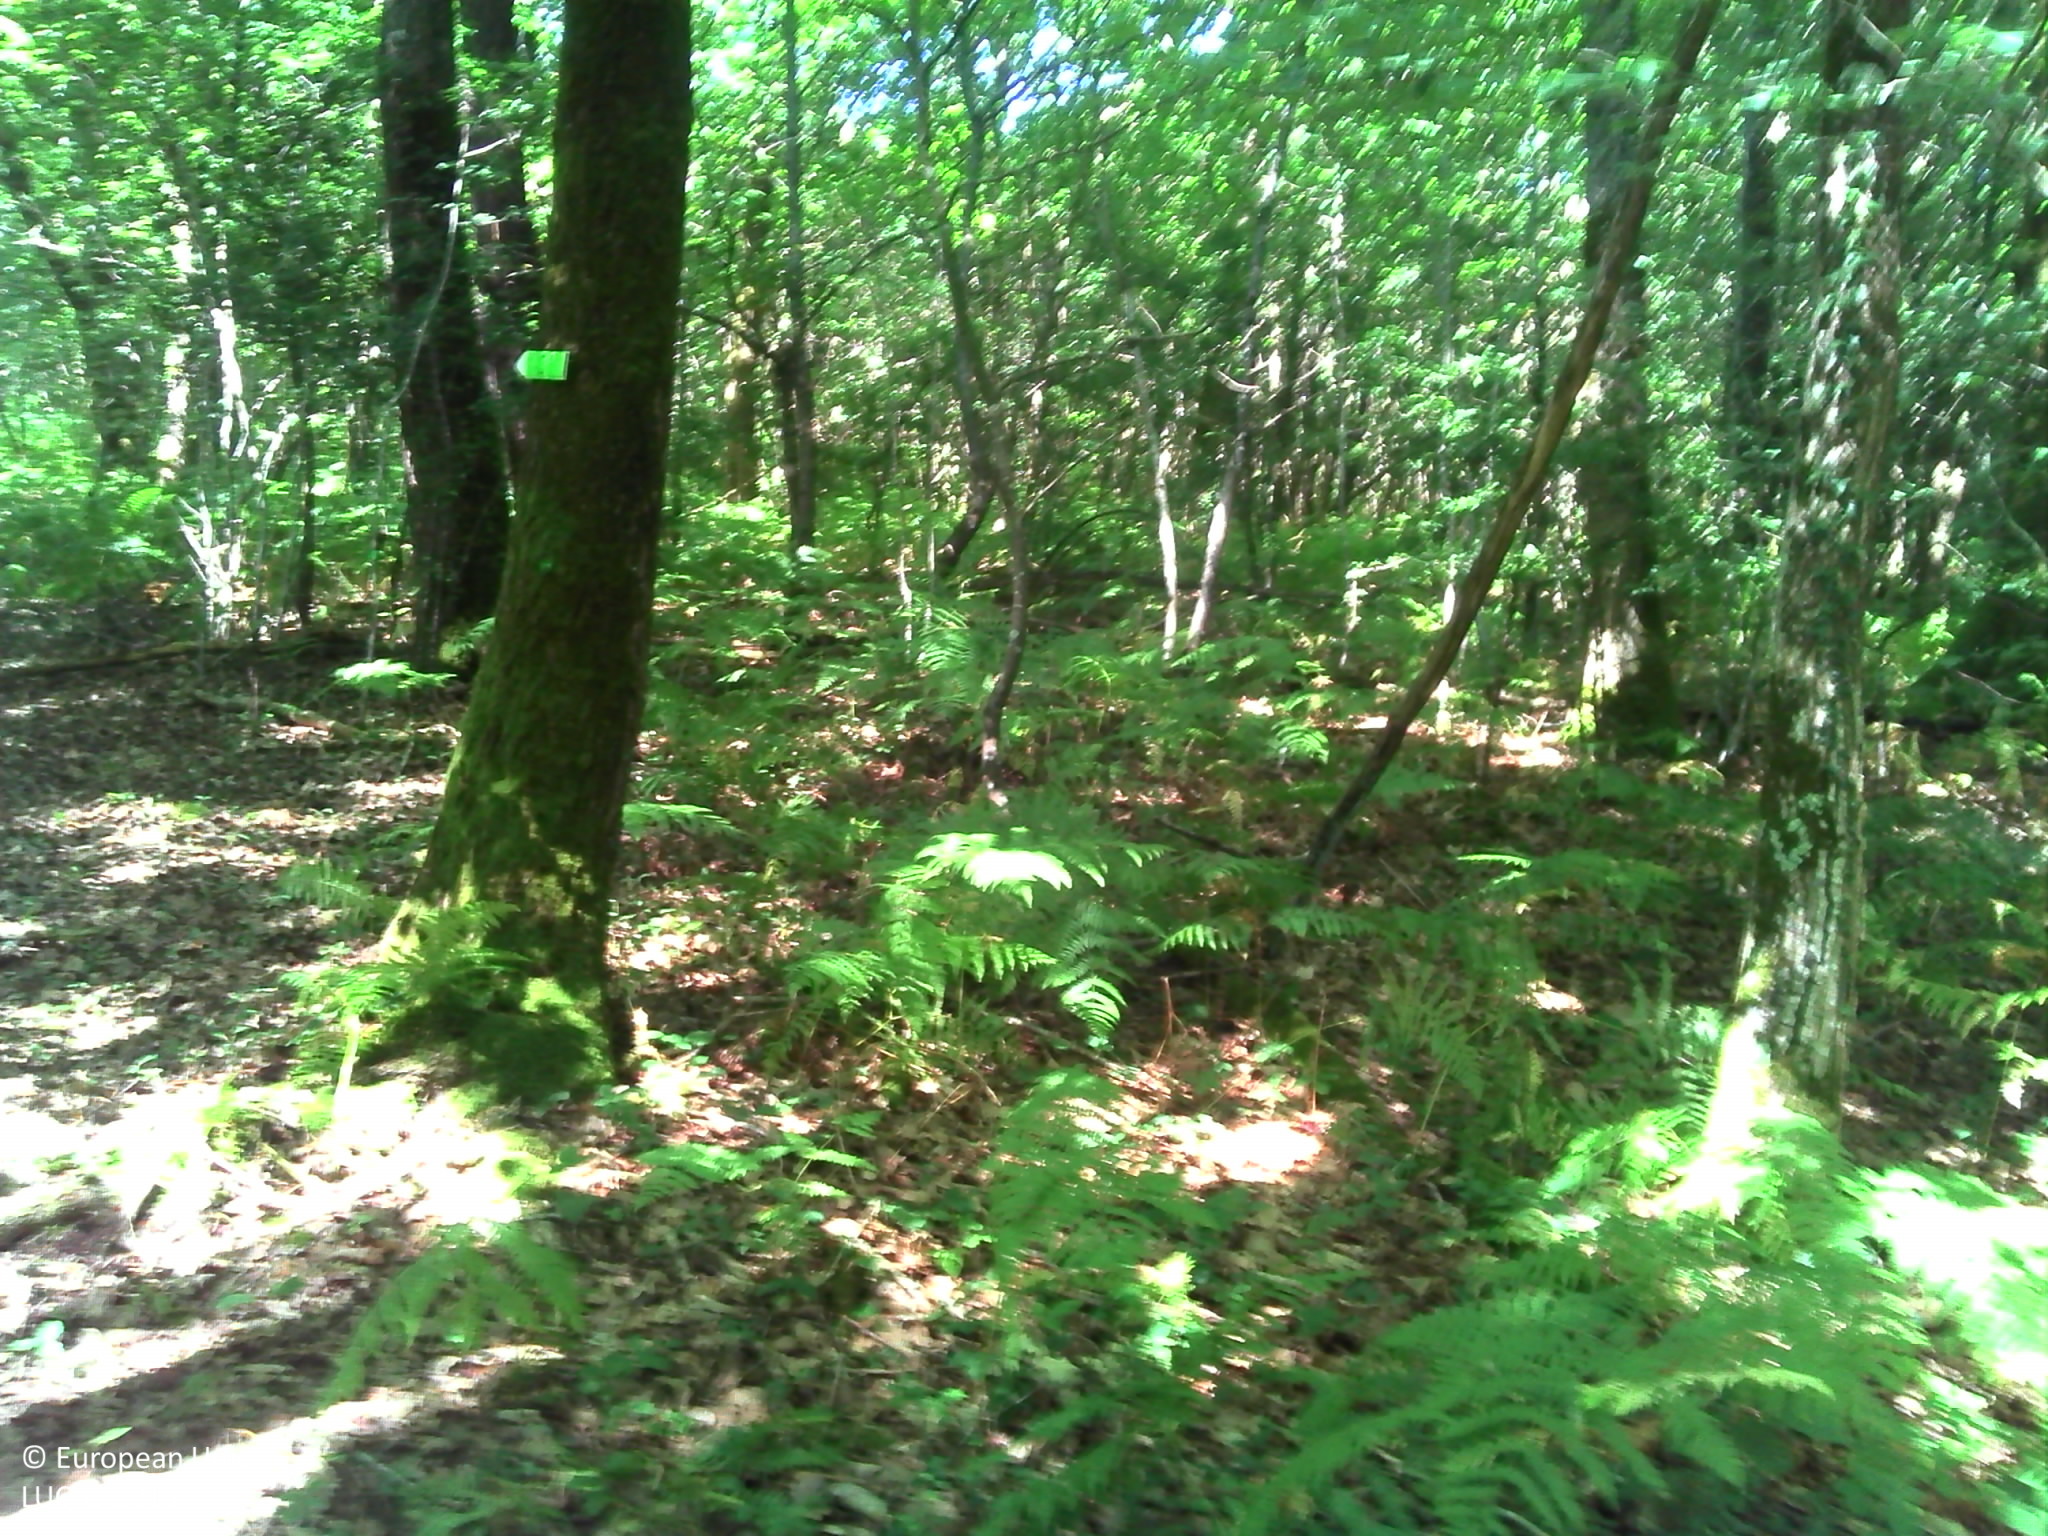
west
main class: Woodland
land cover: Broadleaved woodland
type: acidophilous oak and oak-birch forest
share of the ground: > 75 %
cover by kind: broadleaved forest trees 80 %, herbaceous plants 20 %
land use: Forestry
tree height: > 5 m
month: July
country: FR
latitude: 47.7633
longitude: -2.0188
